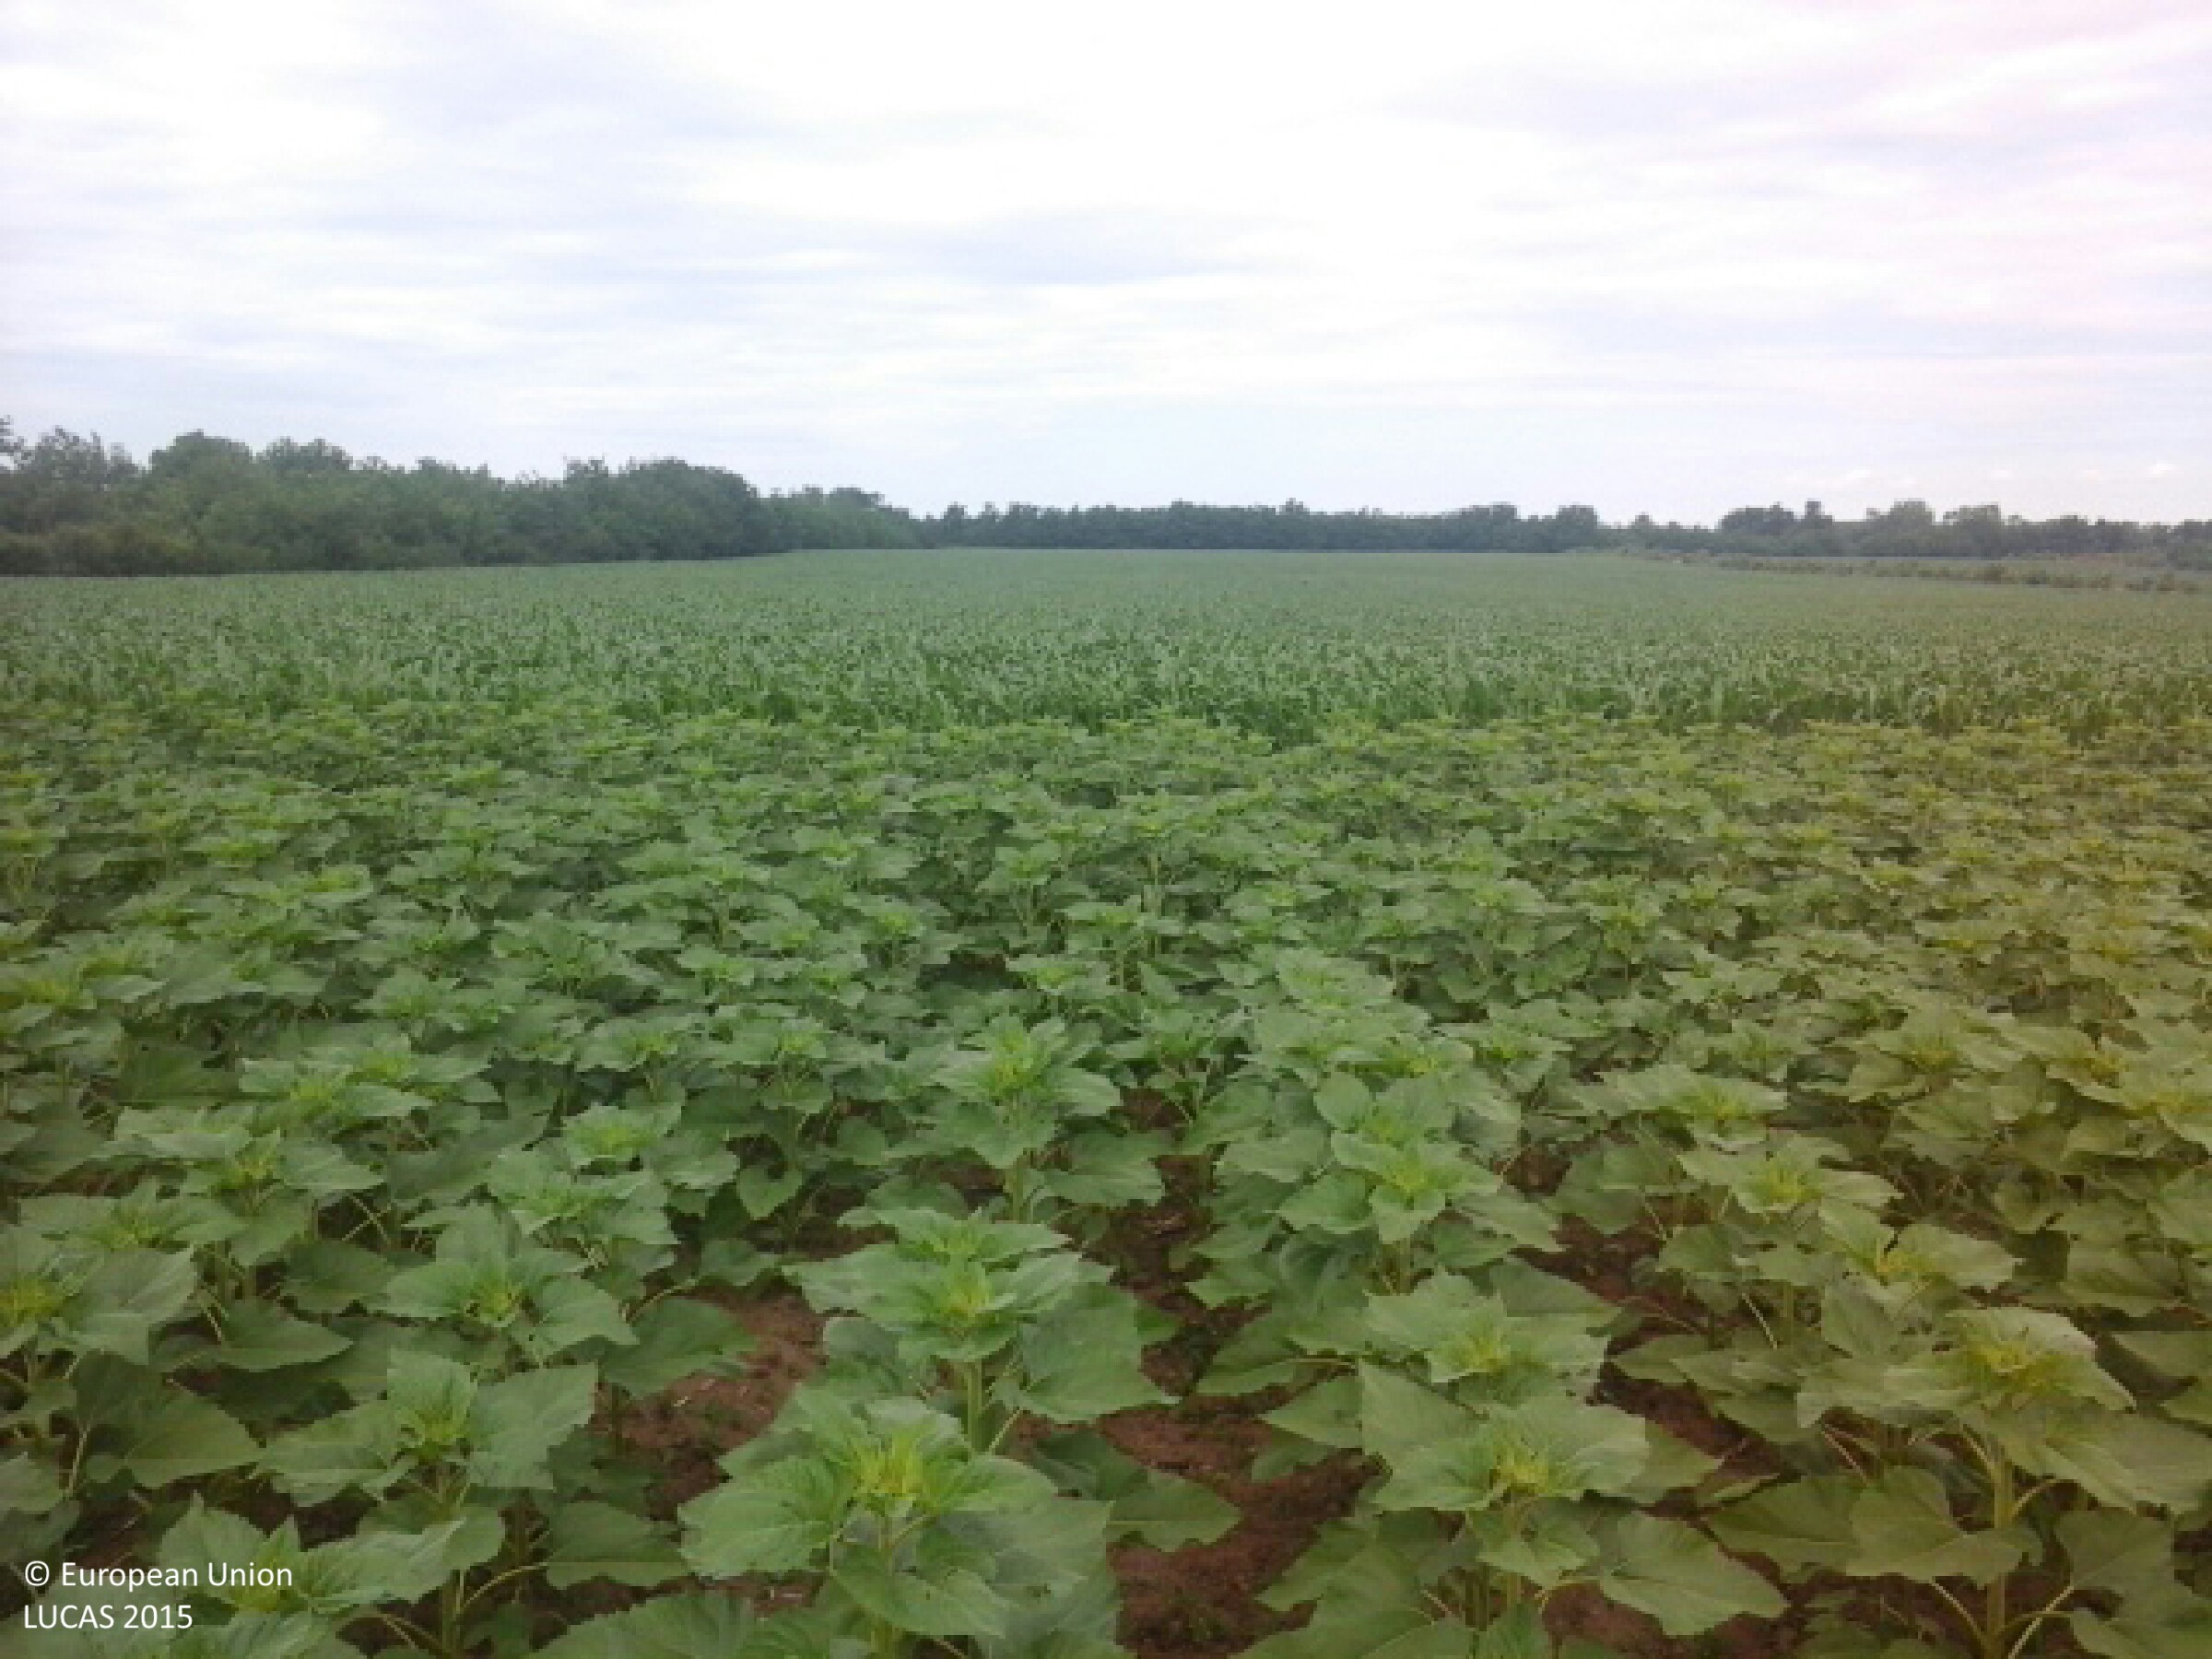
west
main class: Cropland
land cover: Sunflower
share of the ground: 50 - 75 %
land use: Agriculture (excluding fallow land and kitchen gardens)
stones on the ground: < 10 %
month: June
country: HU
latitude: 48.0199
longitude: 21.8352
